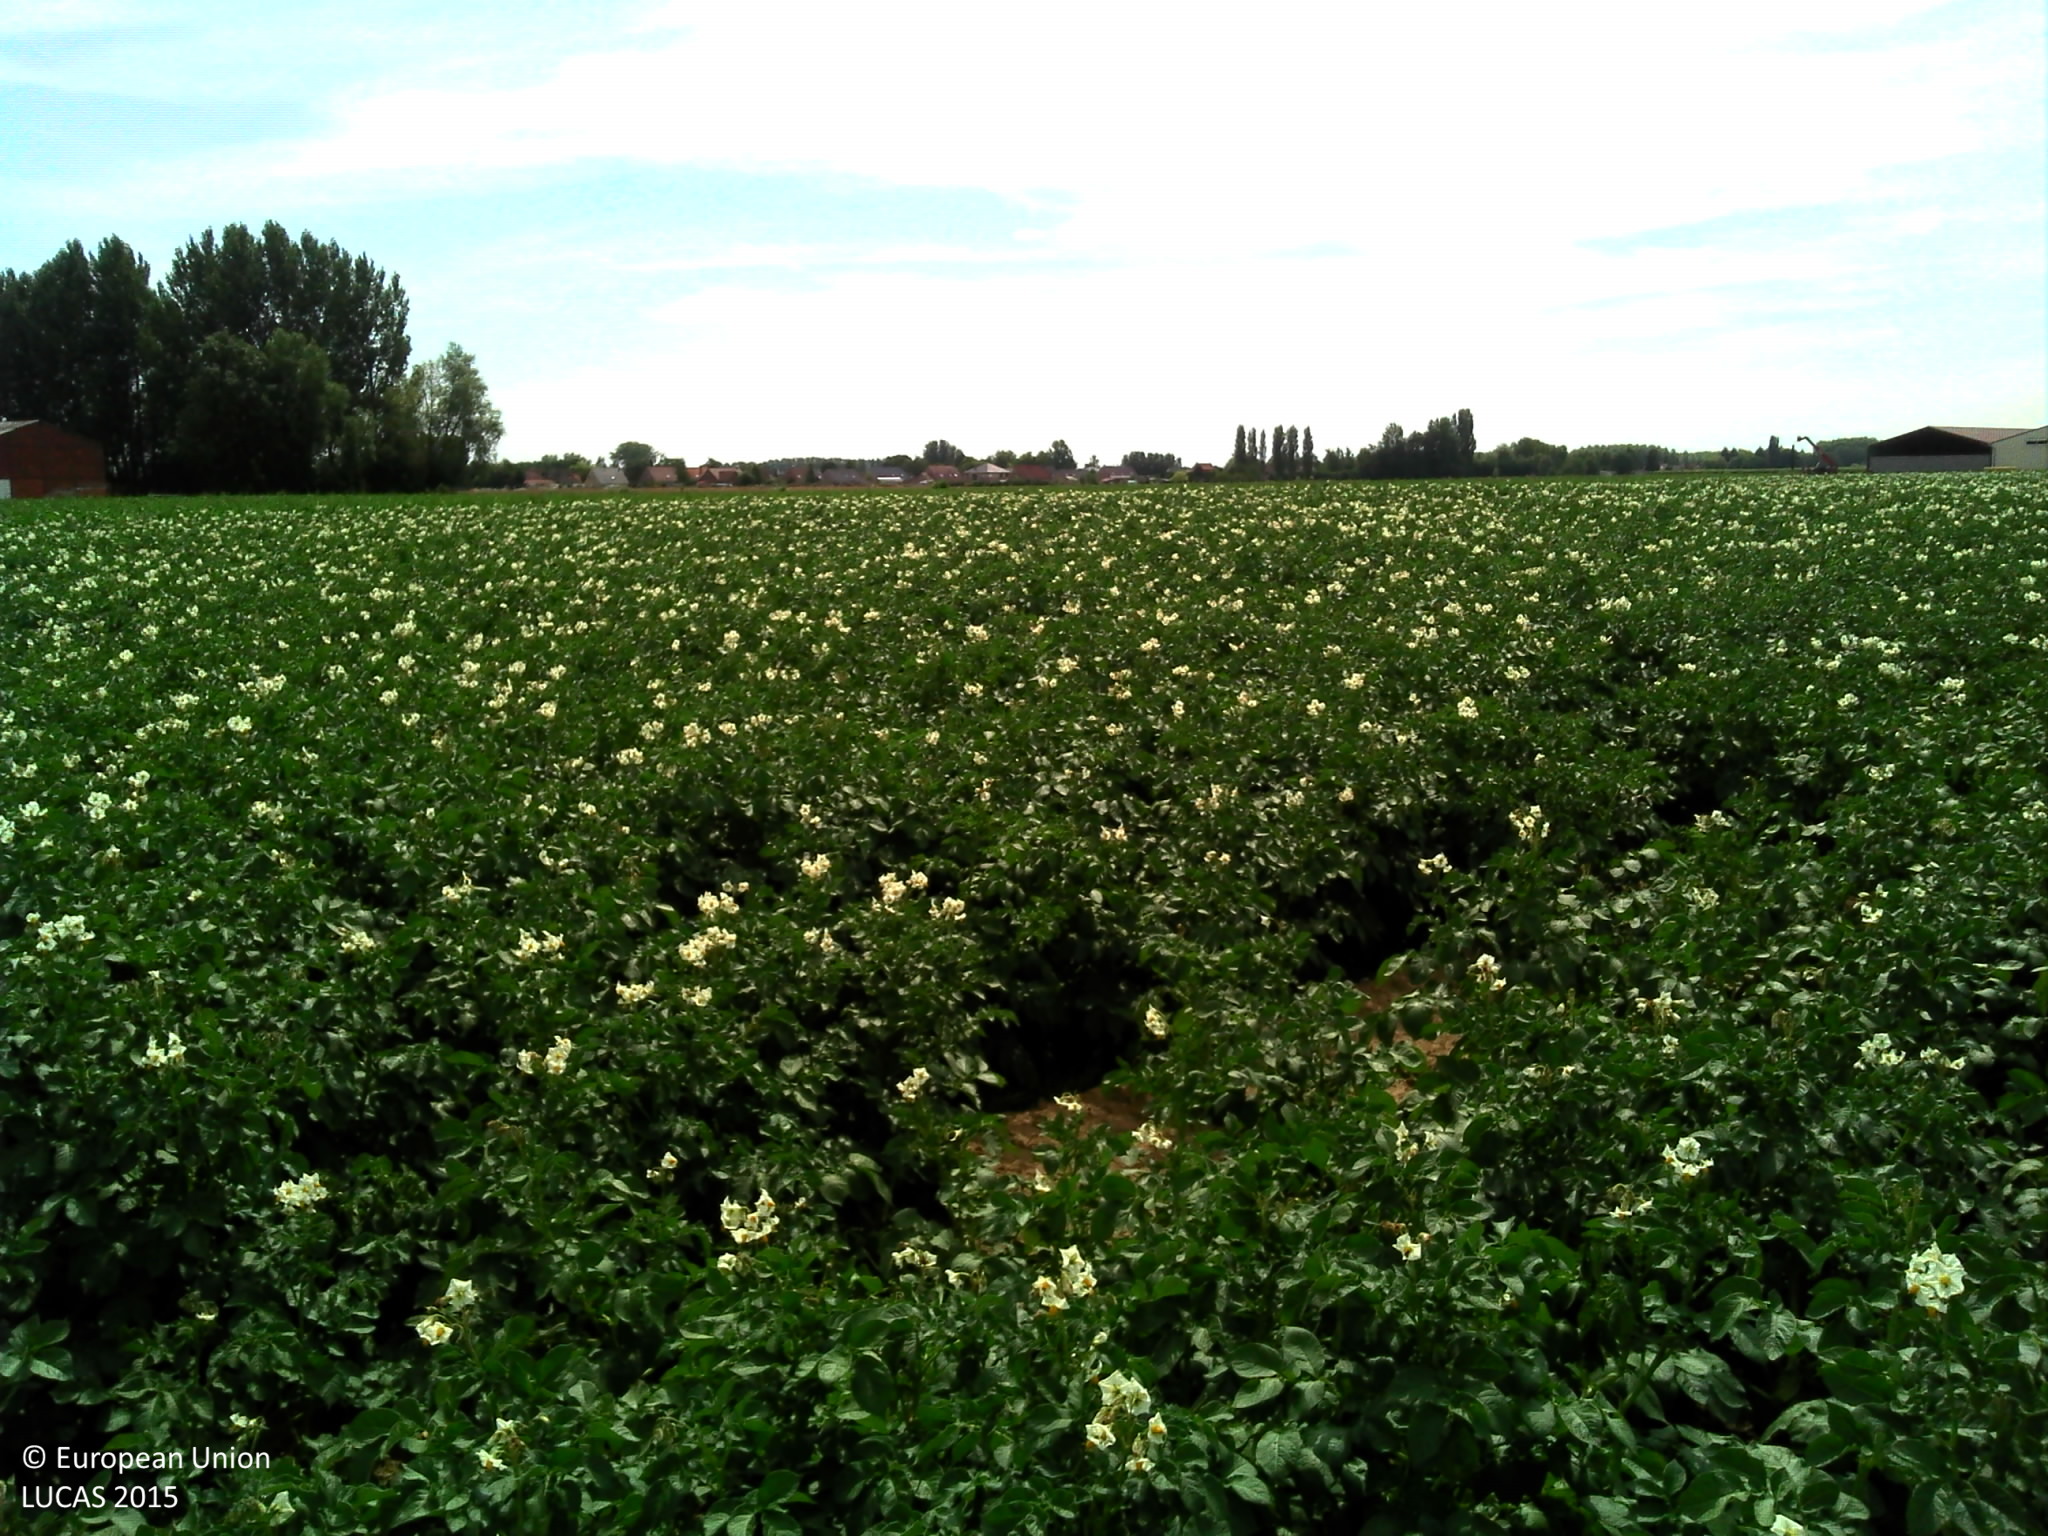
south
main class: Cropland
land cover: Potatoes
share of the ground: > 75 %
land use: Agriculture (excluding fallow land and kitchen gardens)
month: August
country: FR
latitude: 50.6491
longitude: 2.6194
